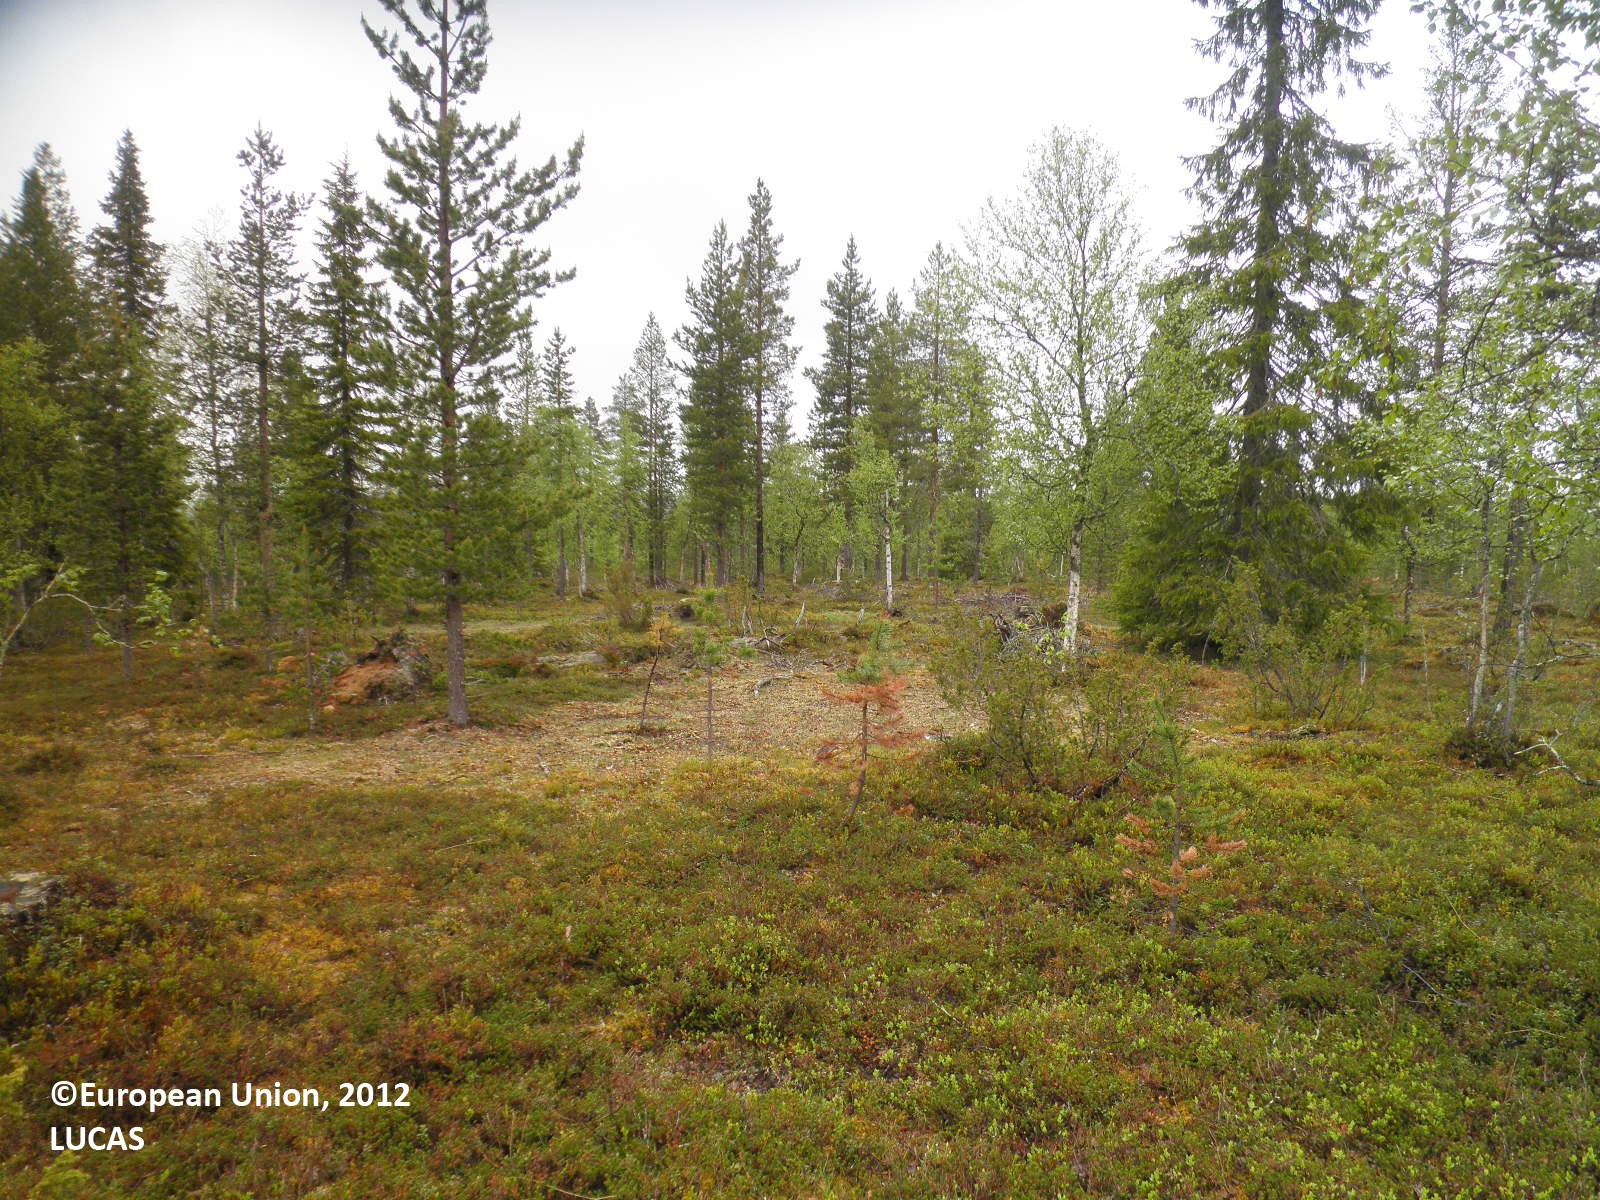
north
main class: Woodland
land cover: Pine dominated mixed woodland
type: boreal forest
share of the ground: 10 - 25 %
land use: Forestry
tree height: > 5 m
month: June
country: FI
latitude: 68.1110
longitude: 25.5435
